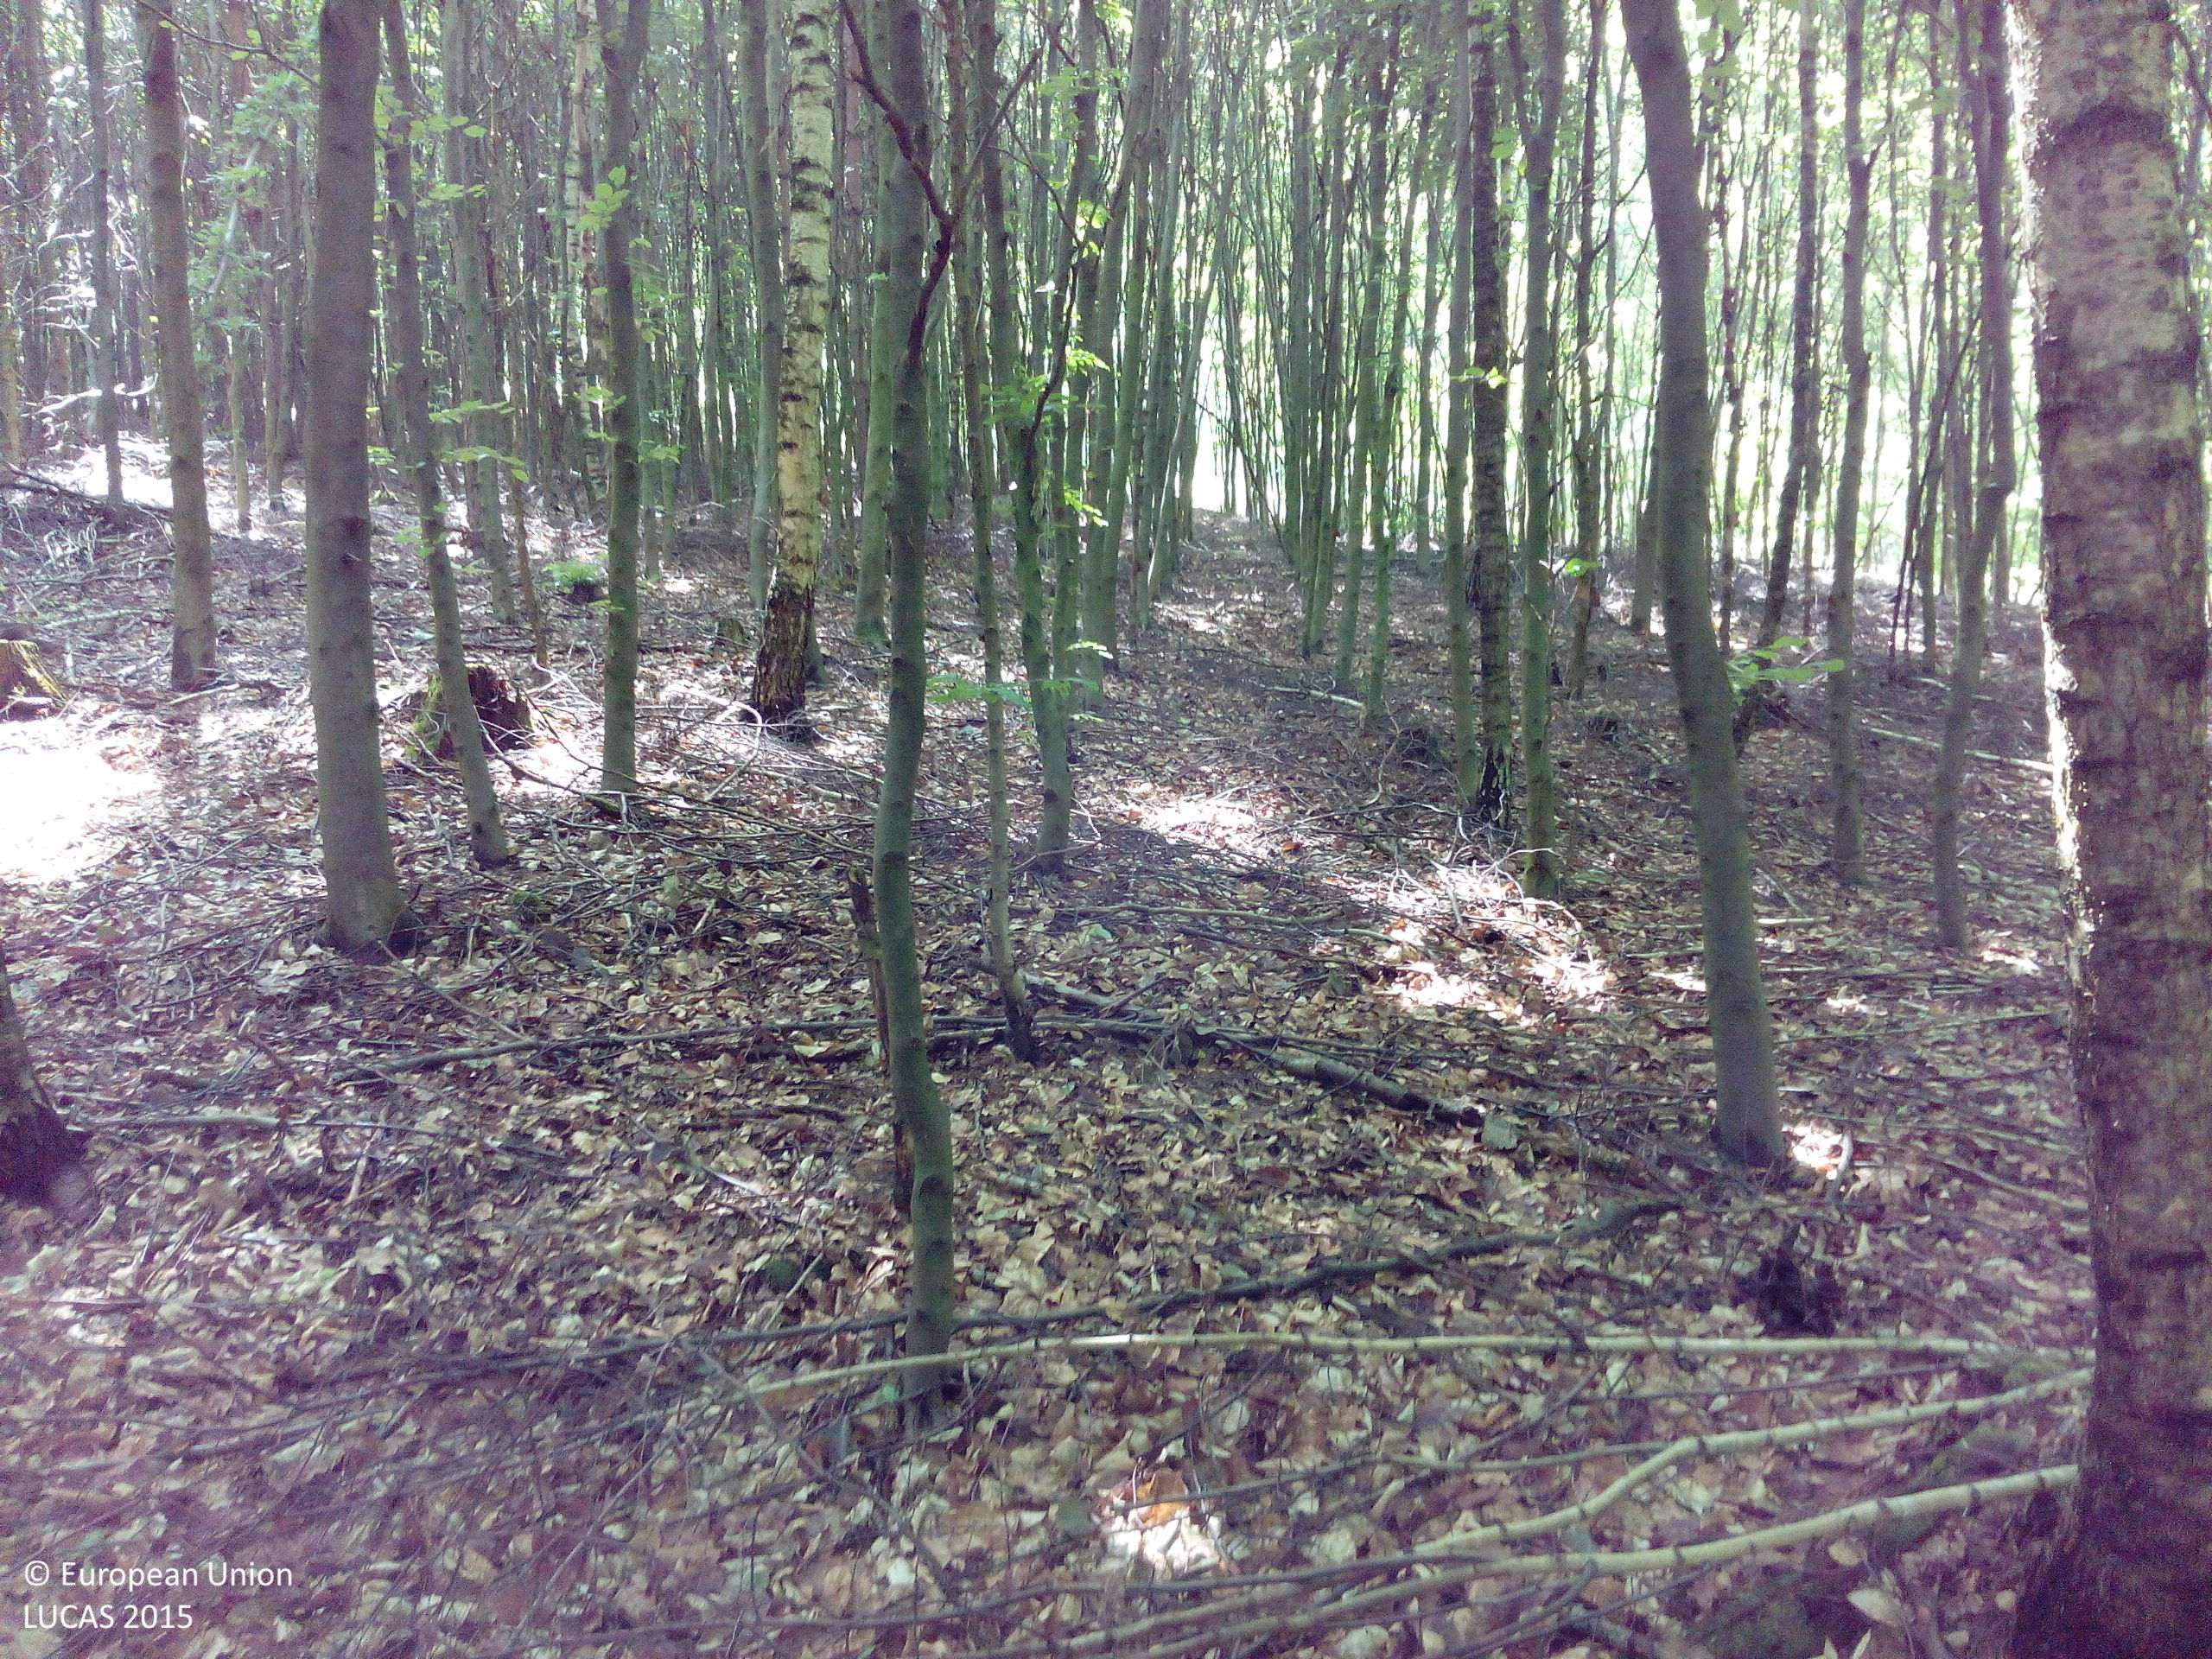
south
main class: Woodland
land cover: Broadleaved woodland
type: beech forest
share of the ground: > 75 %
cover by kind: broadleaved forest trees 90 %, coniferous forest trees 5 %, unconsolidated bare surface 5 %
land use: Forestry
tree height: > 5 m
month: June
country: DE
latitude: 51.0329
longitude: 13.9795
